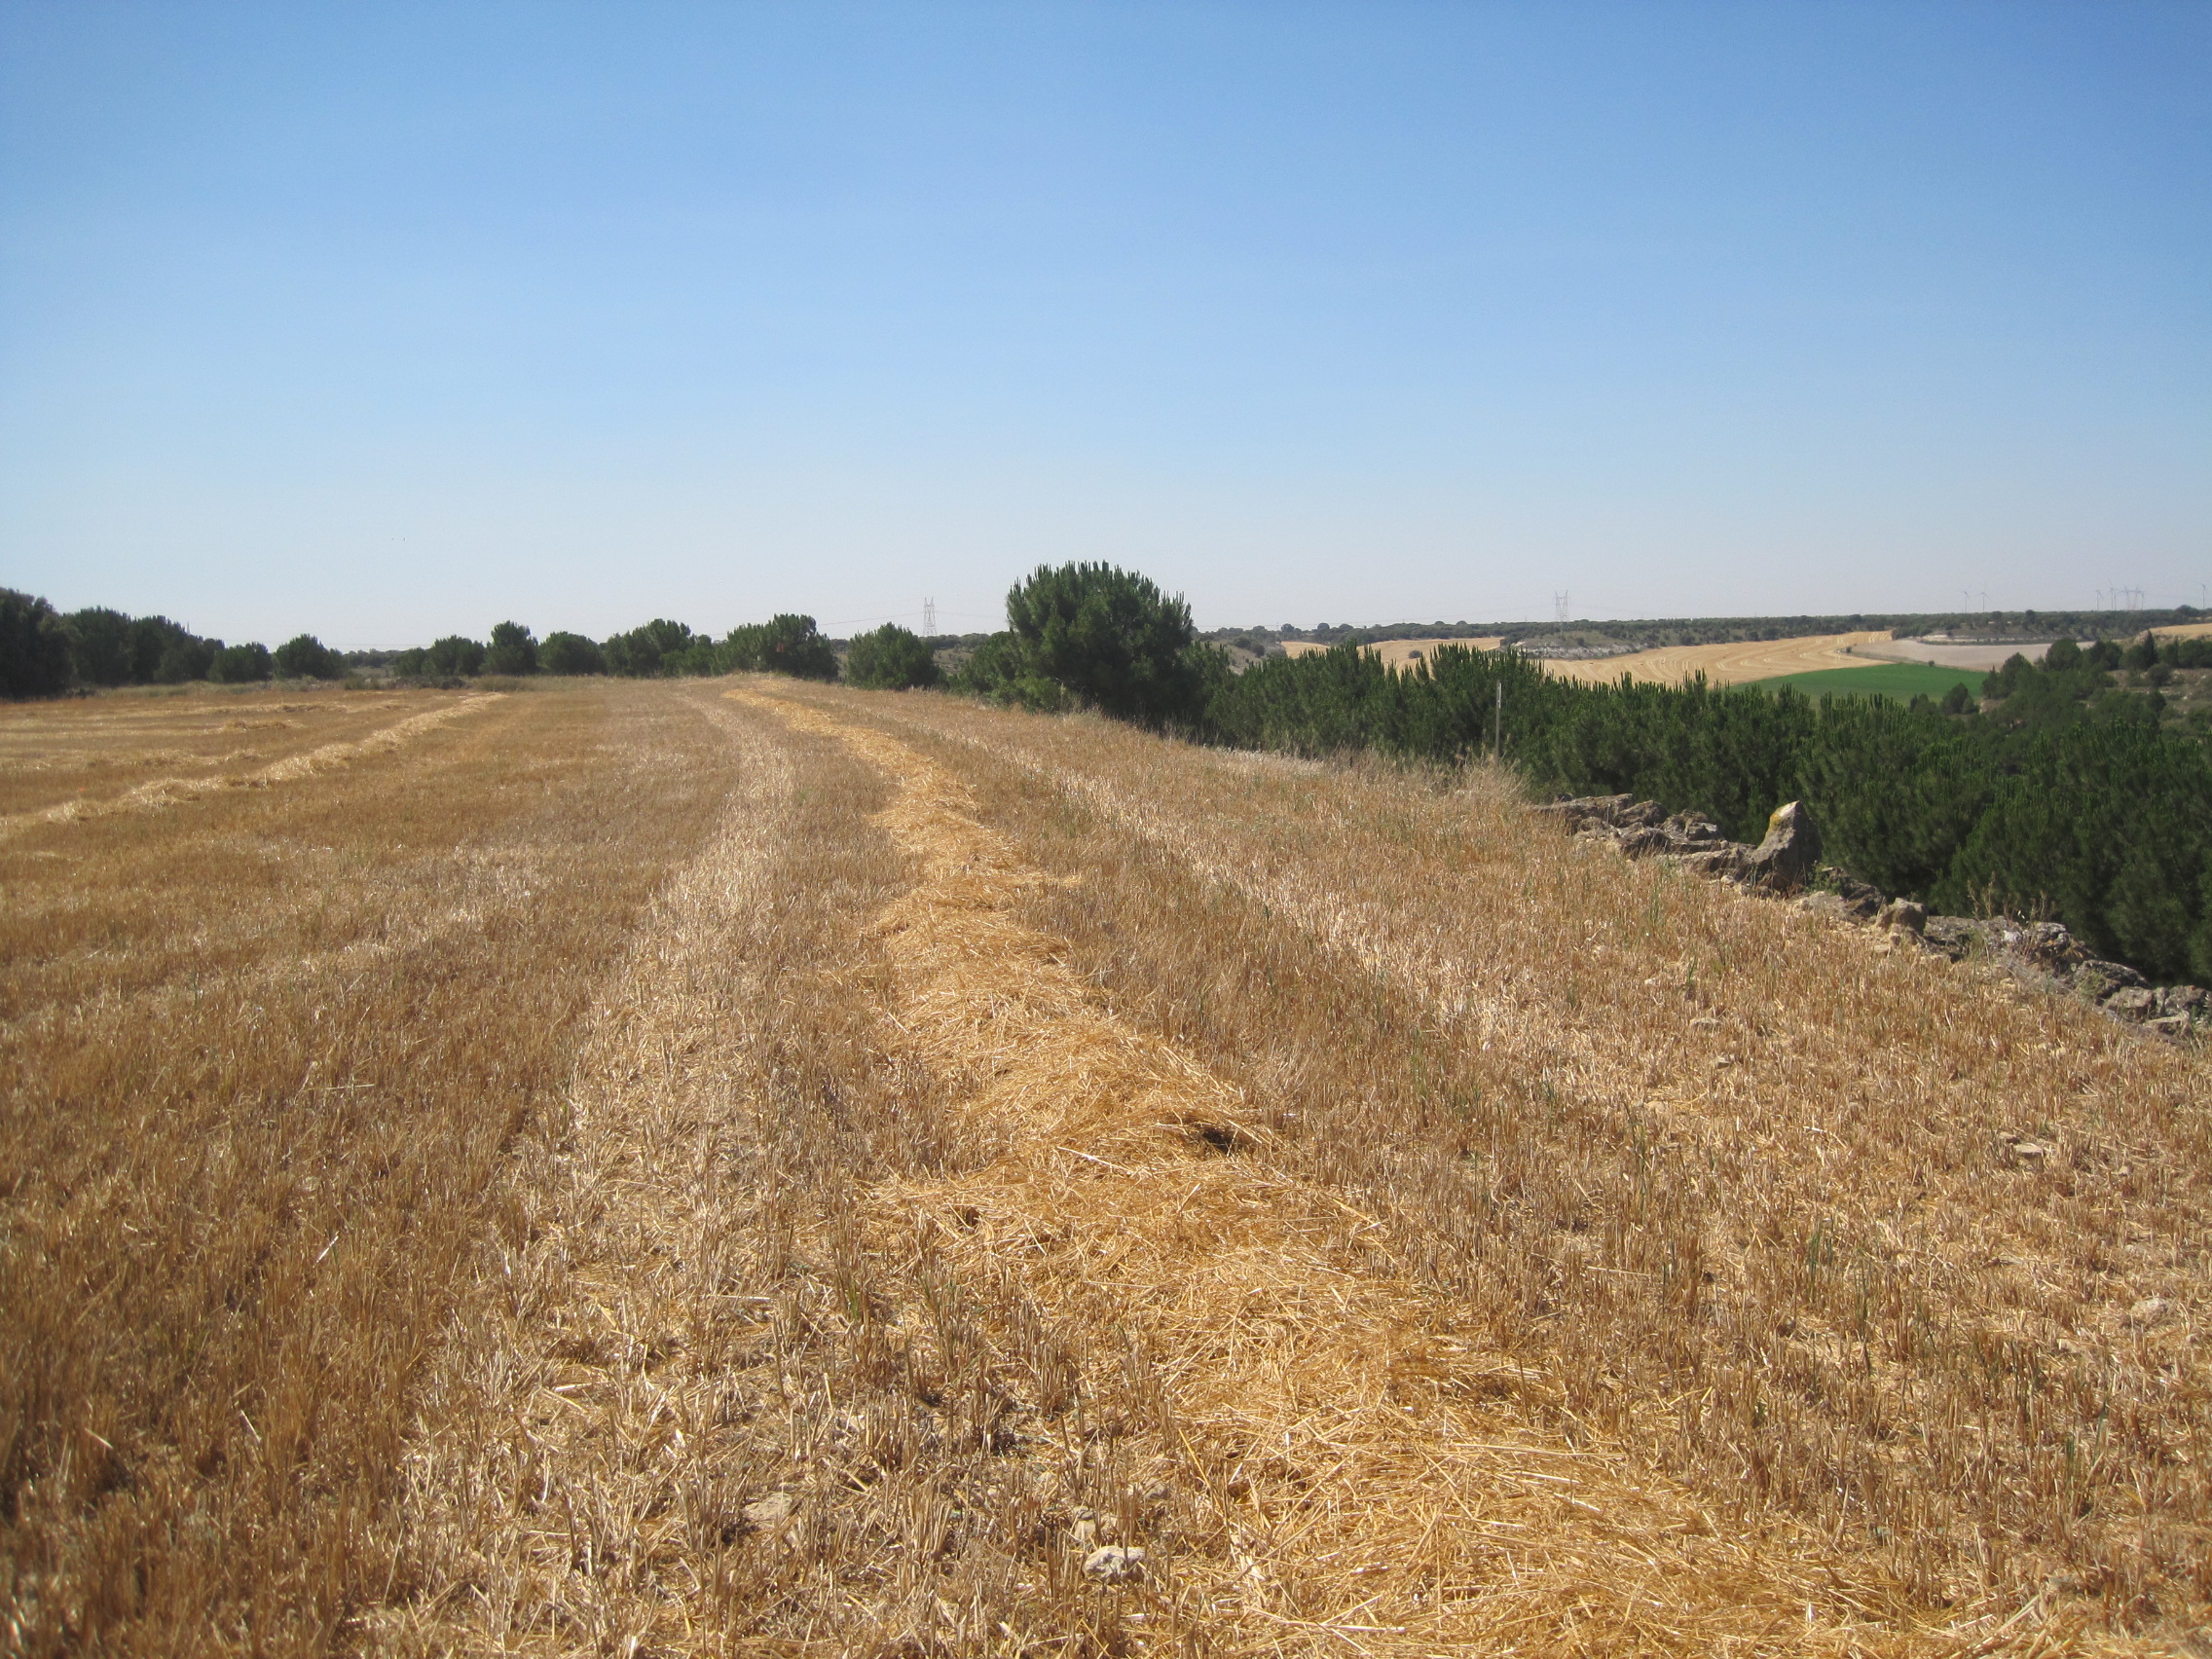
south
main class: Cropland
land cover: Oats
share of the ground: < 10 %
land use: Agriculture (excluding fallow land and kitchen gardens)
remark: Harvested field
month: July
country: ES
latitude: 41.9232
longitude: -4.6988
